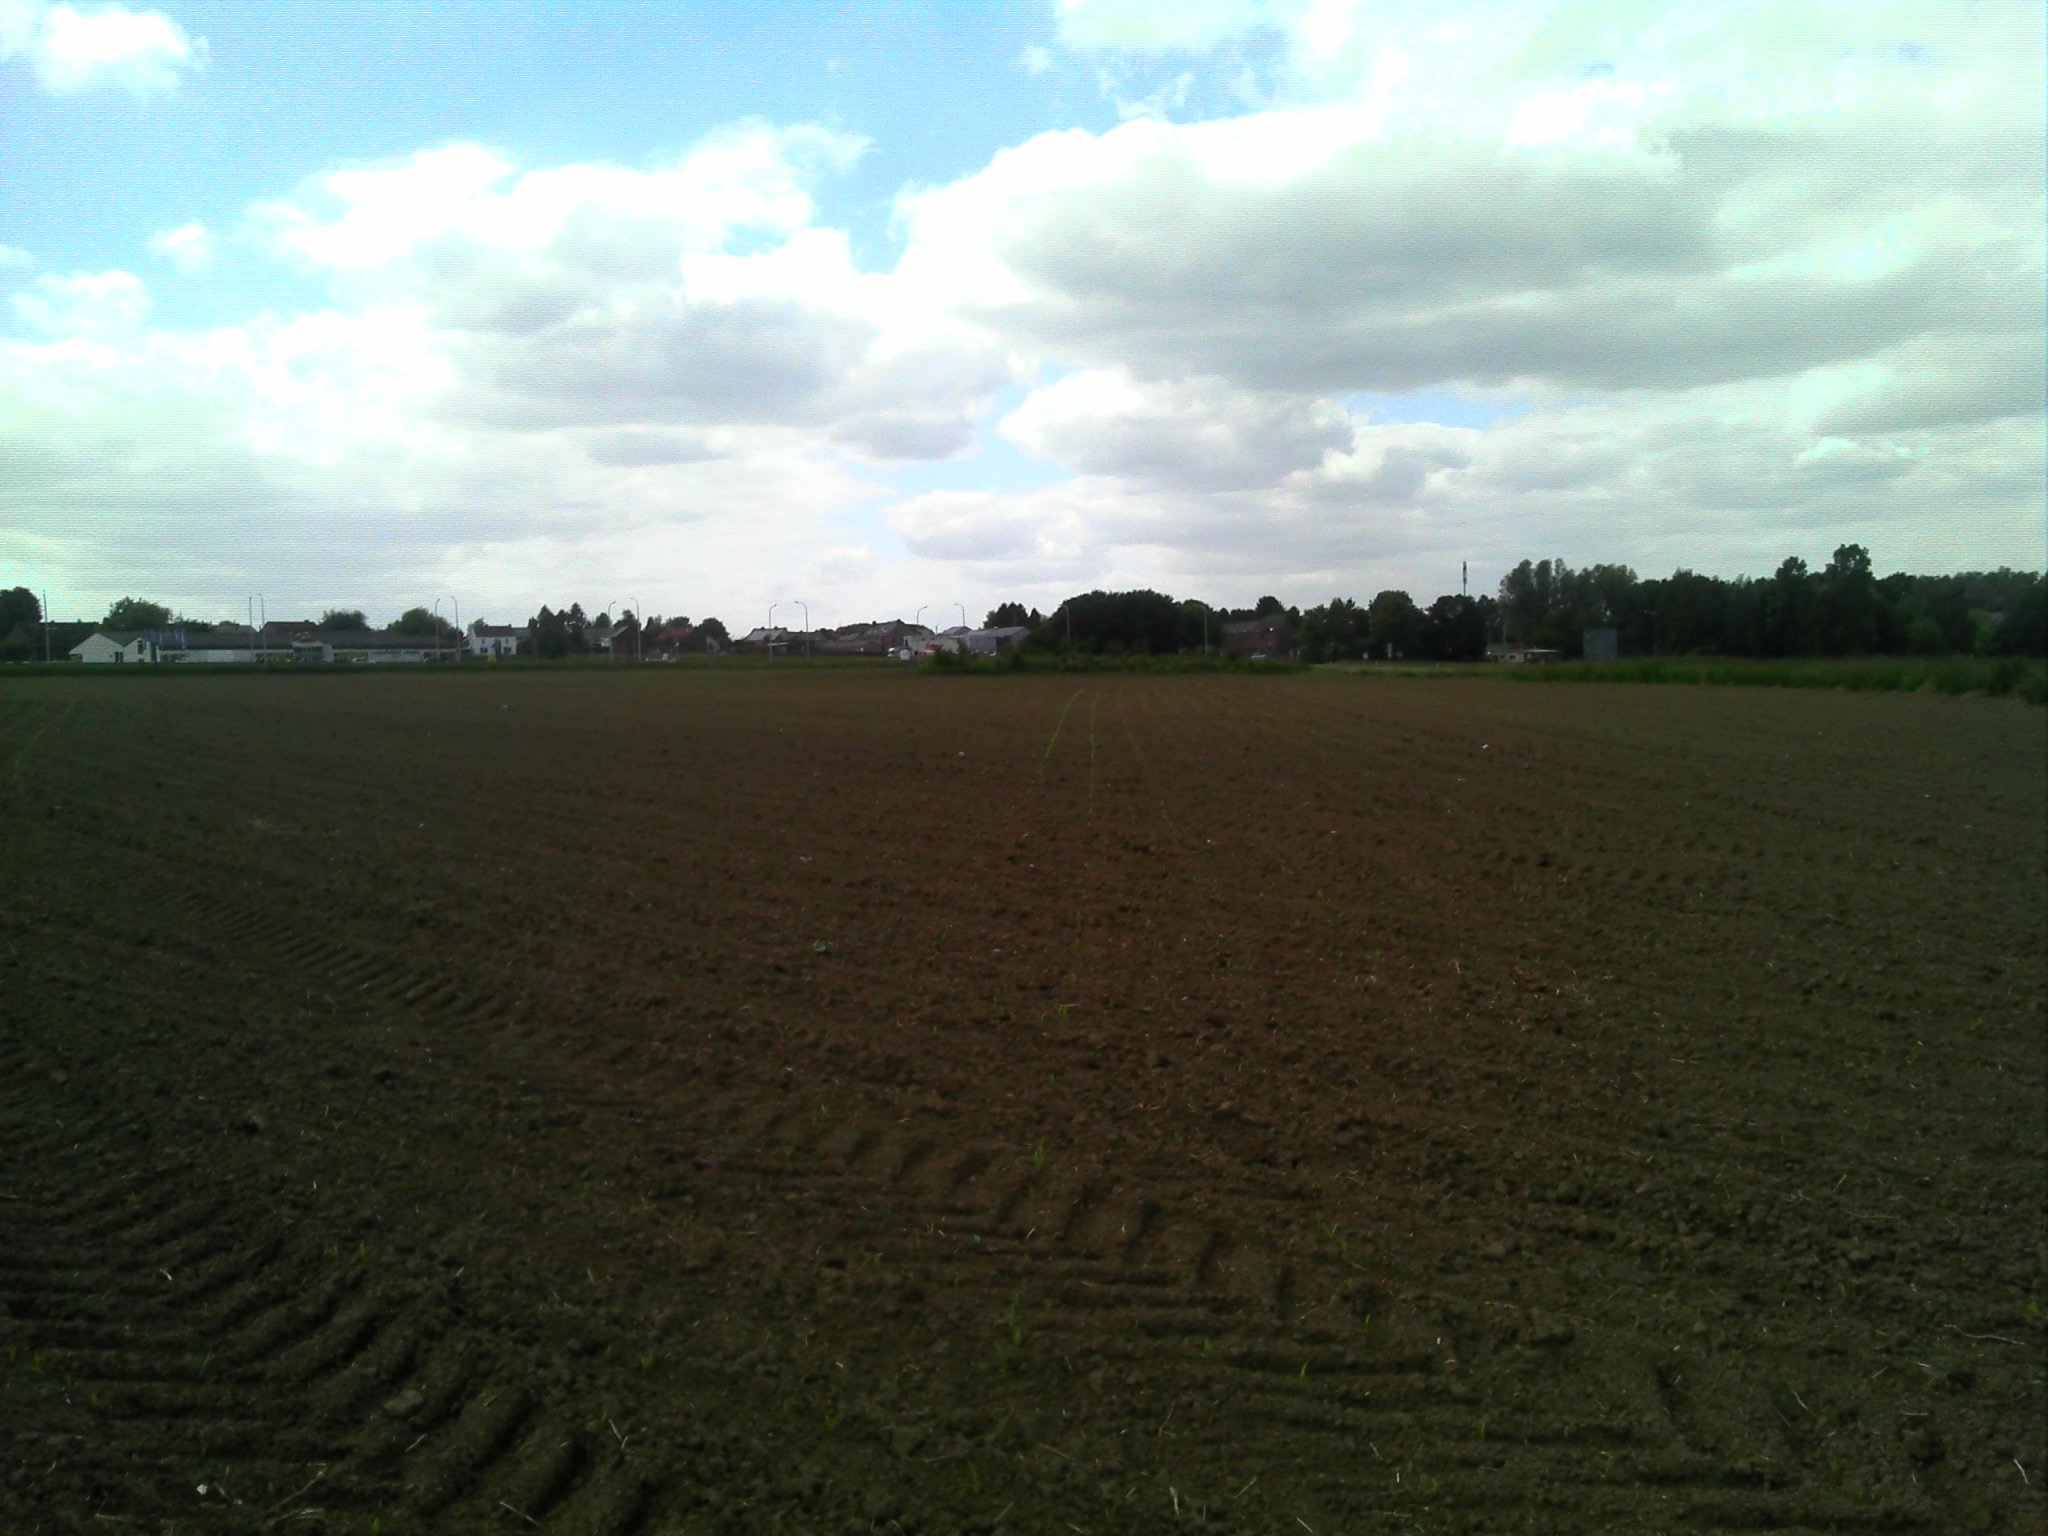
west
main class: Cropland
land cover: Maize
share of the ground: < 10 %
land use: Agriculture (excluding fallow land and kitchen gardens)
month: June
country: BE
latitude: 50.4721
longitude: 4.6279
